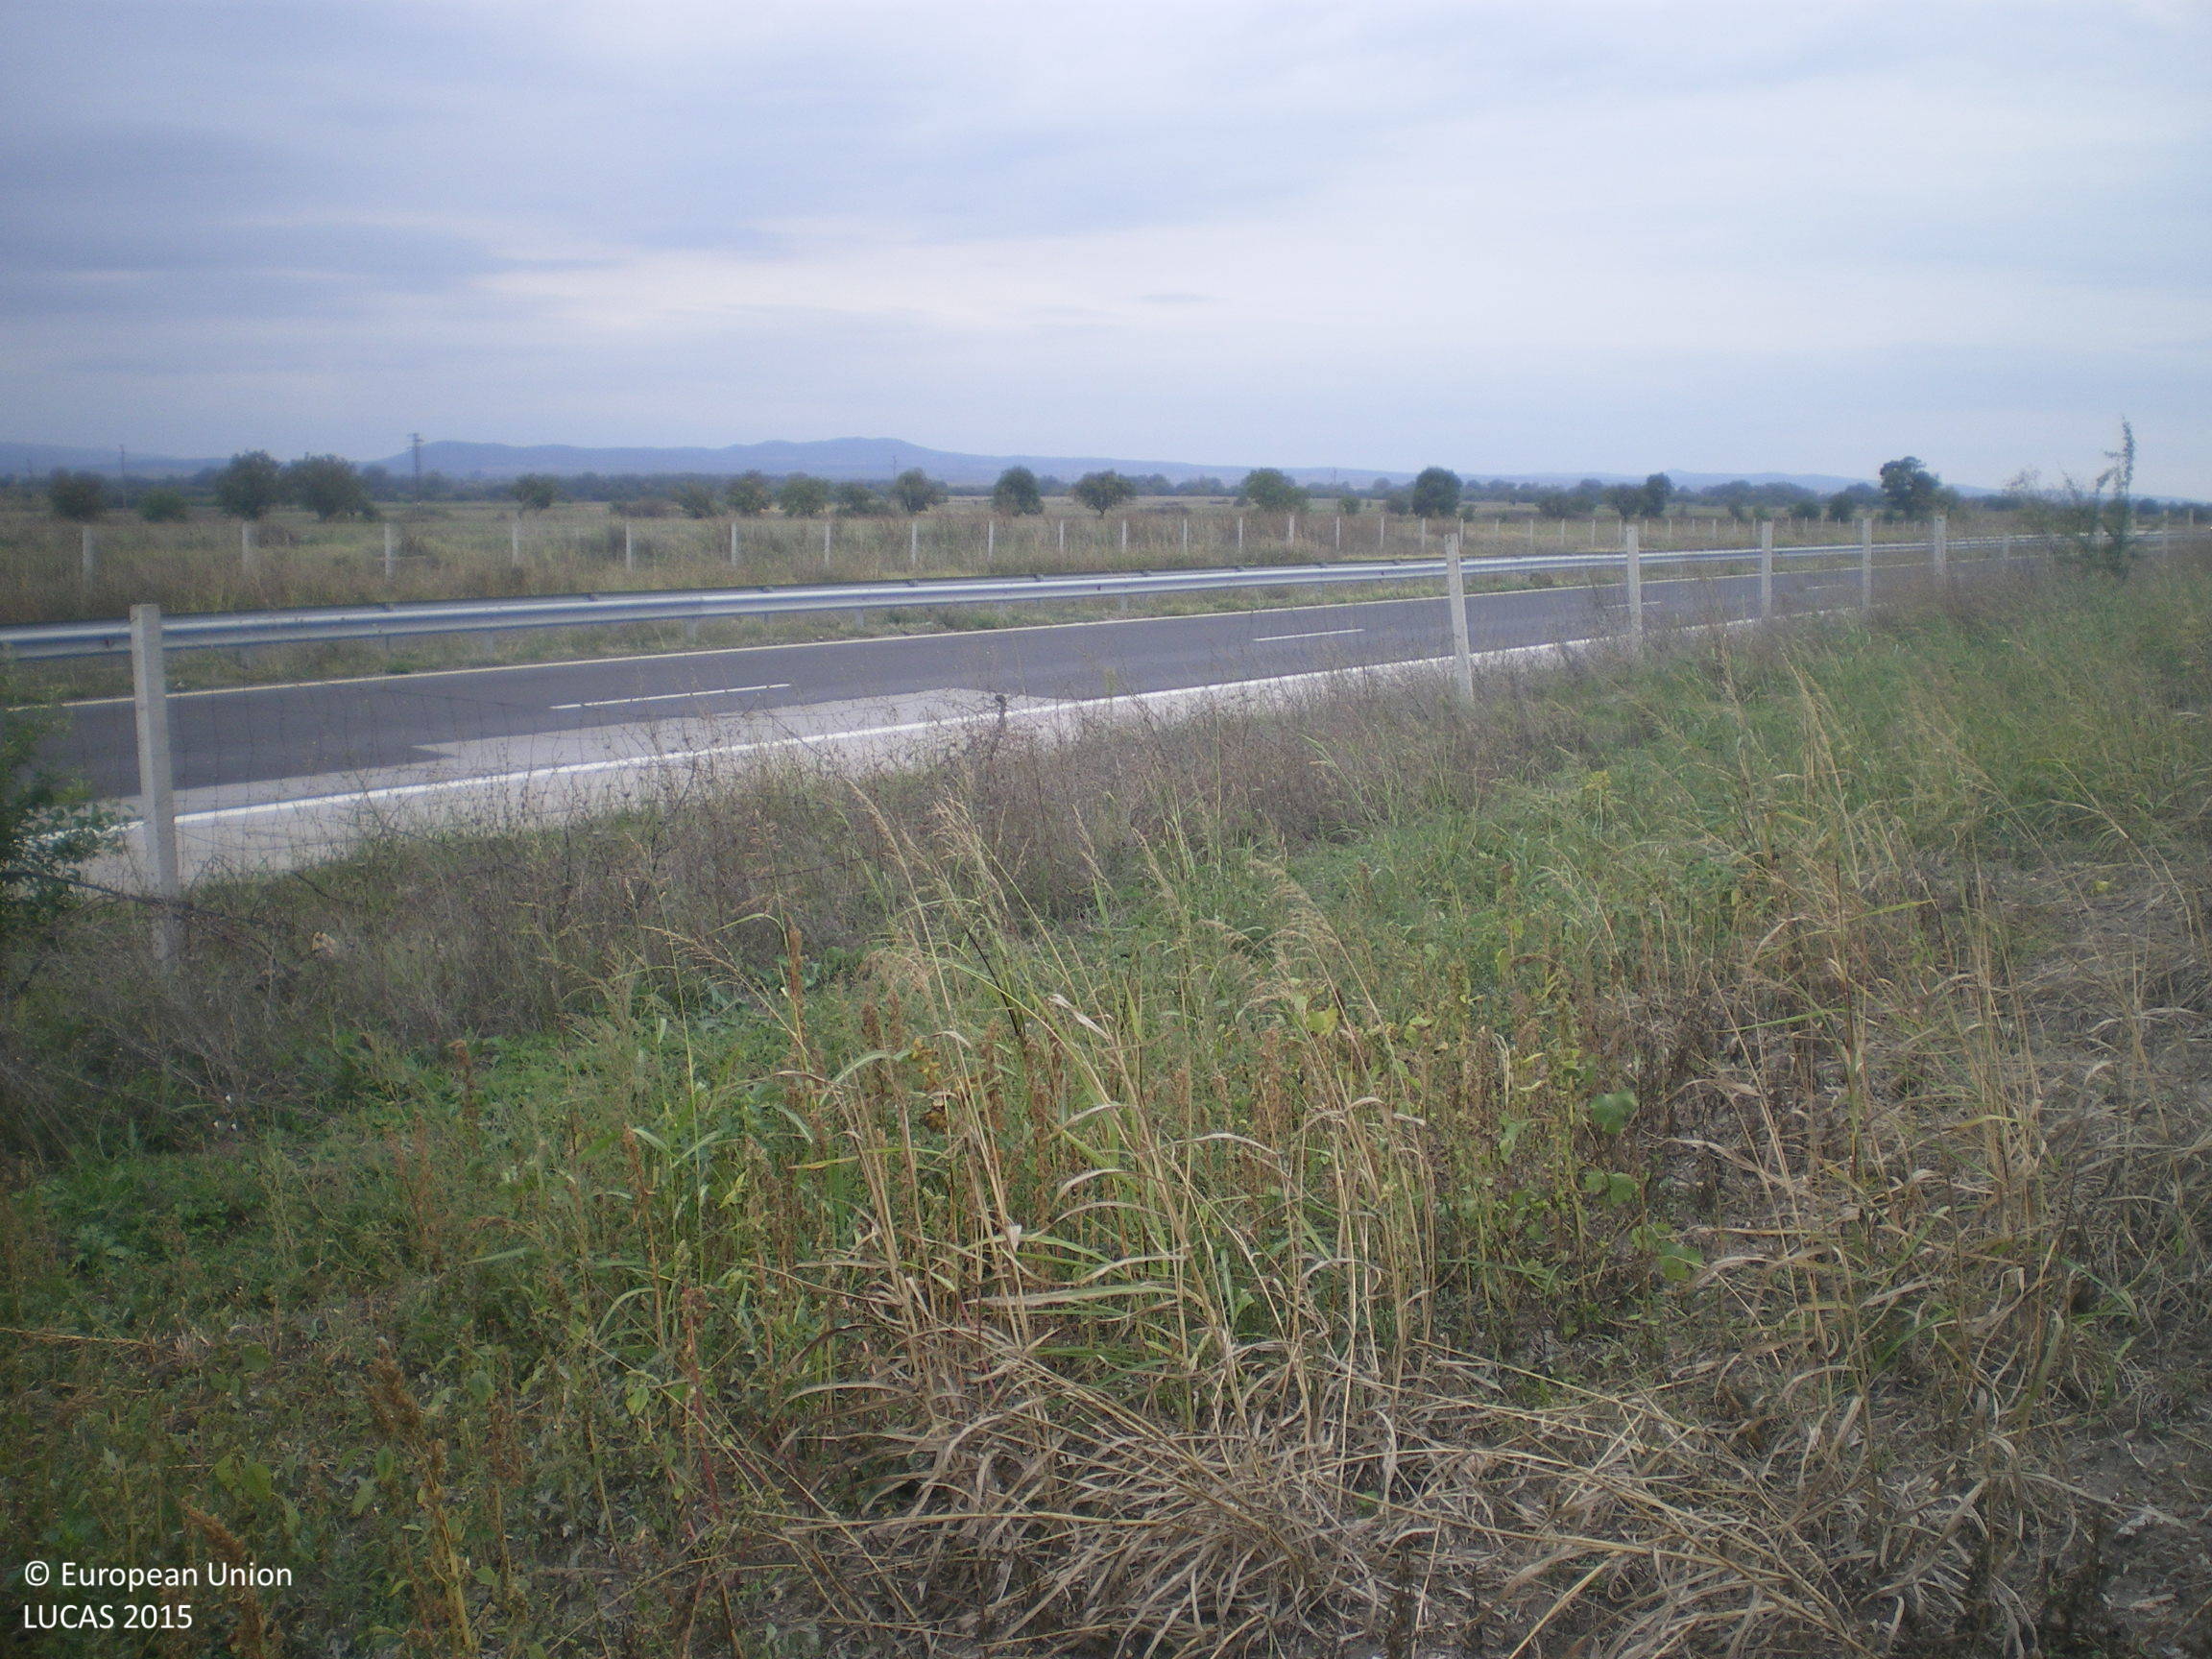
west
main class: Cropland
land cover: Other fresh vegetables
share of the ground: 10 - 25 %
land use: Agriculture (excluding fallow land and kitchen gardens)
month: October
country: BG
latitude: 41.8261
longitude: 26.1489
